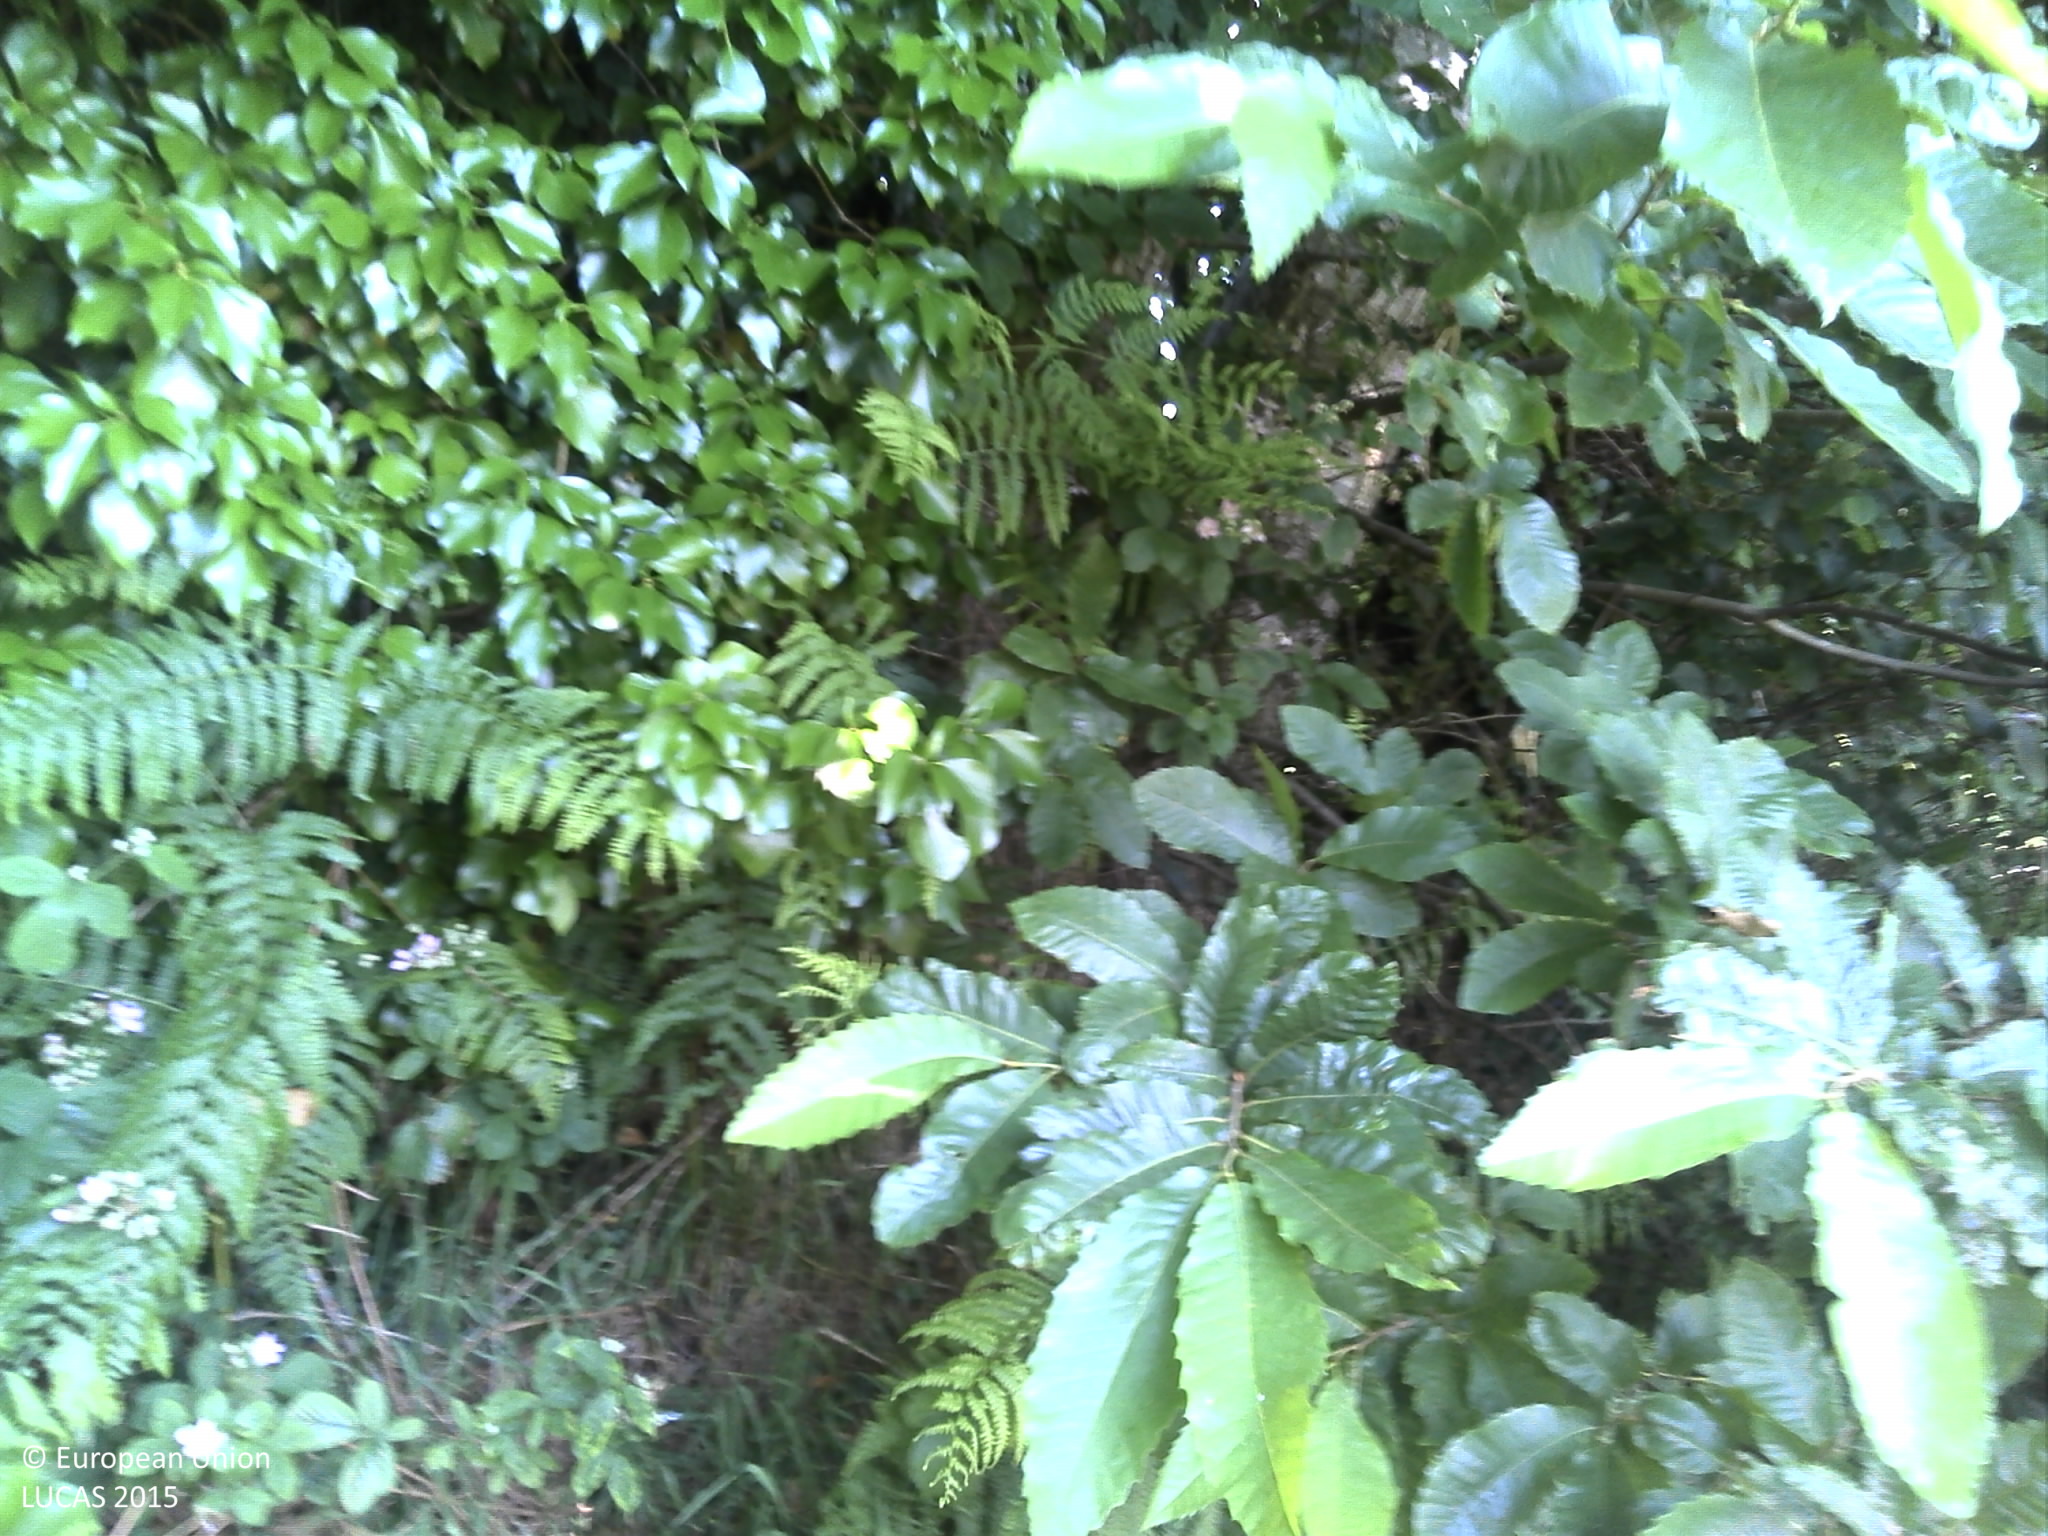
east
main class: Woodland
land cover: Broadleaved woodland
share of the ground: > 75 %
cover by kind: broadleaved forest trees 100 %
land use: Agriculture (excluding fallow land and kitchen gardens)
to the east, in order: Broadleaved woodland; Ditches and canals; Grass margins; Paved roads, cycling and walking lanes; Grass margins; Ditches and canals; Electric lines; Grass margins; Ditches and canals; Barley; Lines of trees; Maize; Broadleaved woodland; Maize
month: June
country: FR
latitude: 48.1869
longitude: -3.6800
